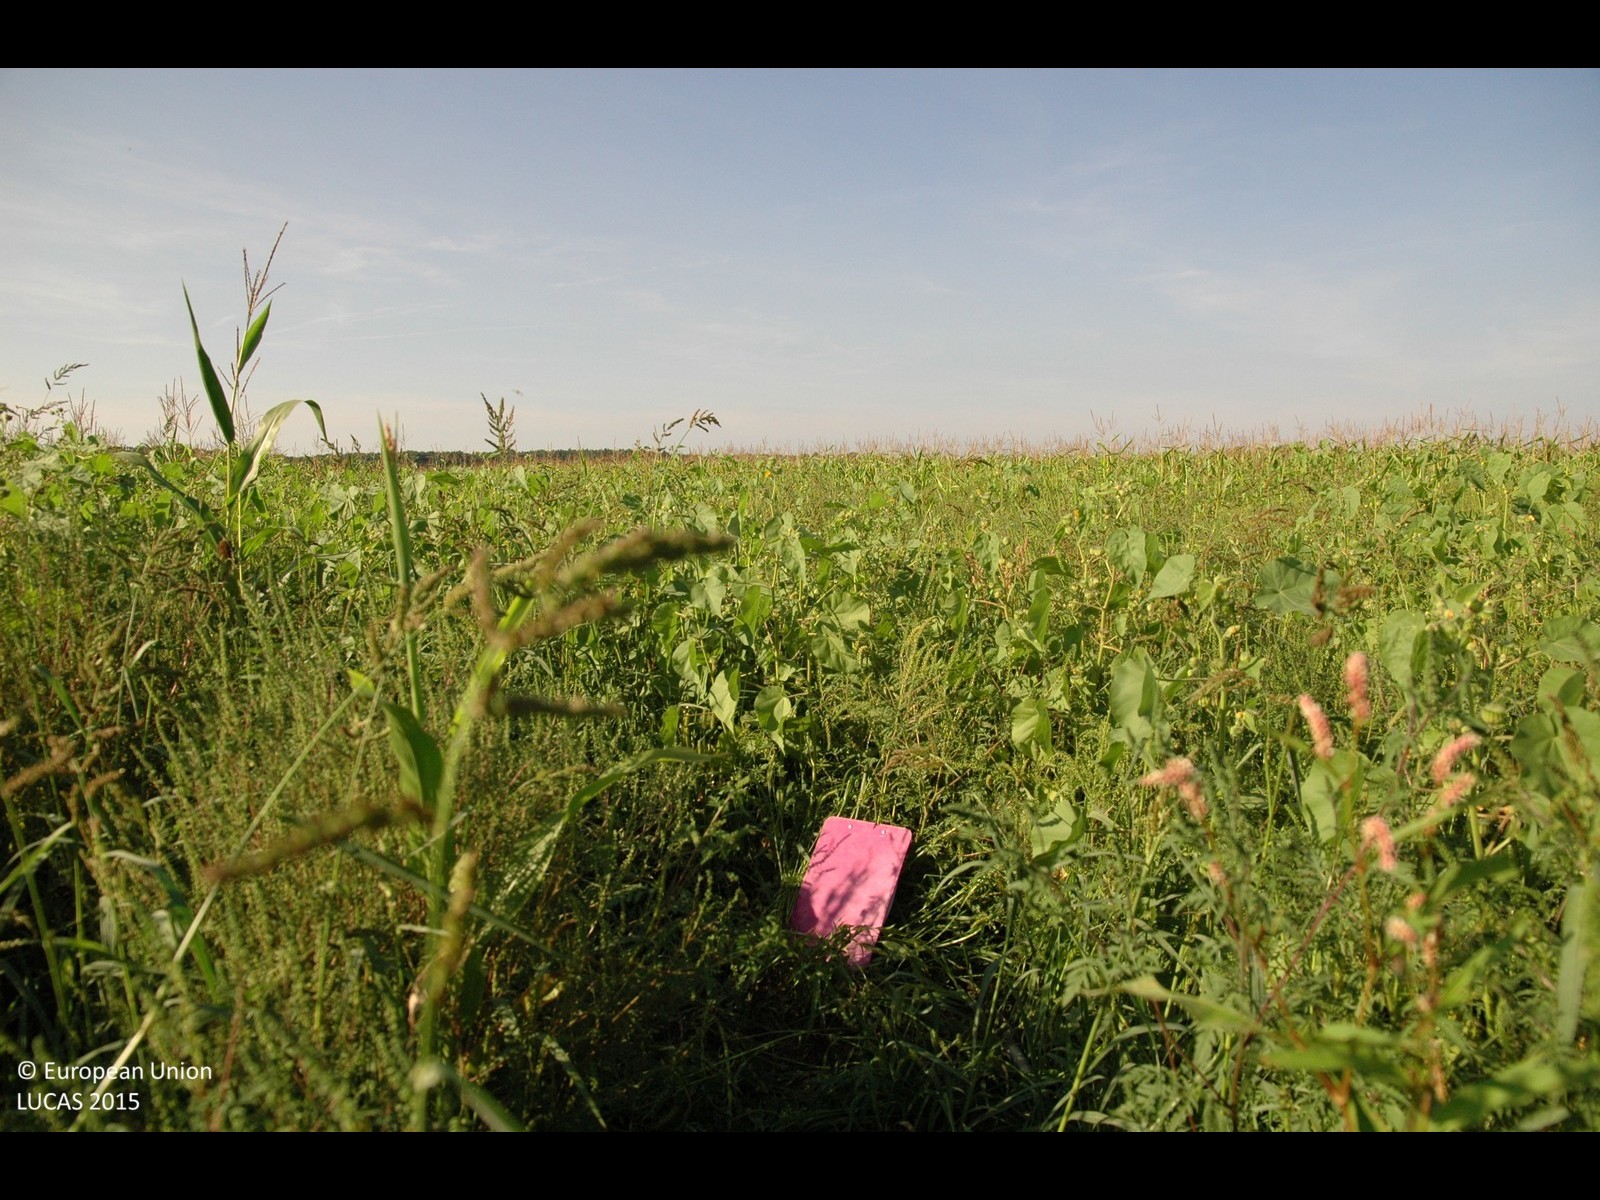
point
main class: Grassland
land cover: Spontaneously vegetated surfaces
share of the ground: > 75 %
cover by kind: herbaceous plants 100 %
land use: Fallow land
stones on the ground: < 10 %
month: August
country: HR
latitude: 46.1250
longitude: 16.9512
